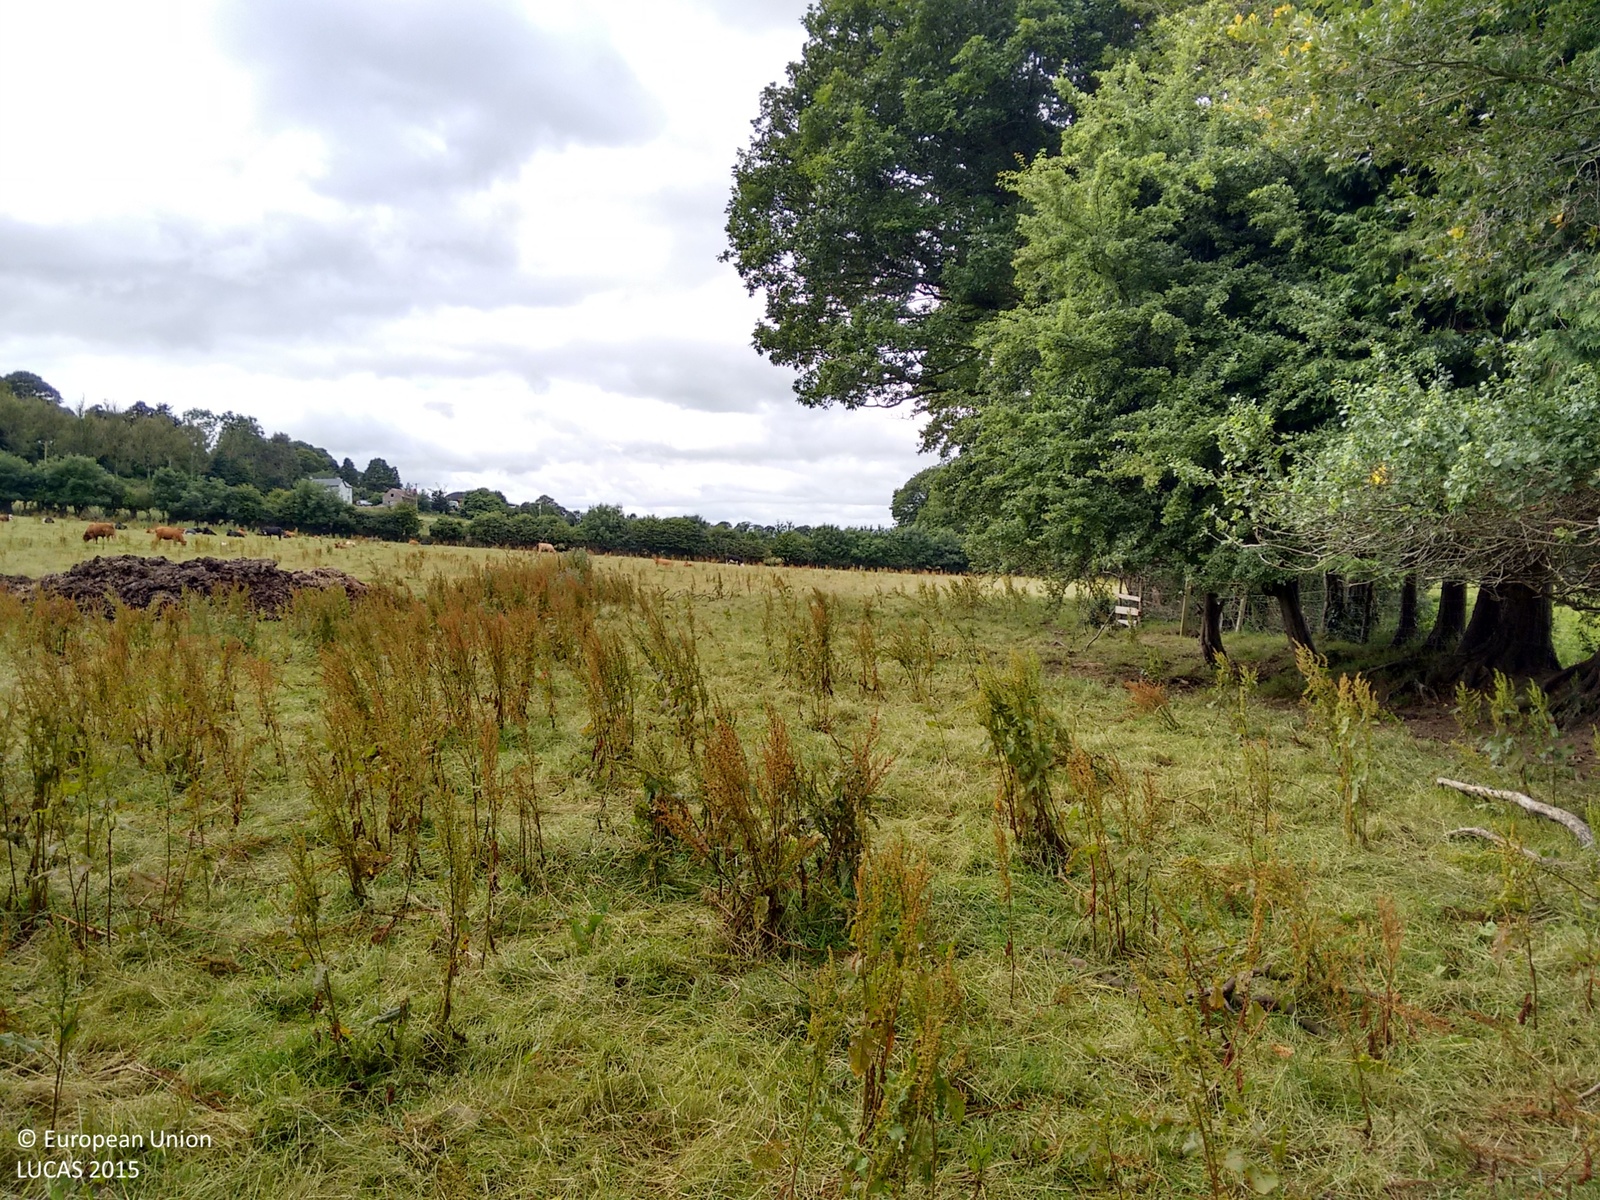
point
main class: Grassland
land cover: Grassland without tree/shrub cover
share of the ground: > 75 %
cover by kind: herbaceous plants 90 %, unconsolidated bare surface 10 %
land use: Agriculture (excluding fallow land and kitchen gardens)
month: July
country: IE
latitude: 52.8352
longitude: -6.3171
